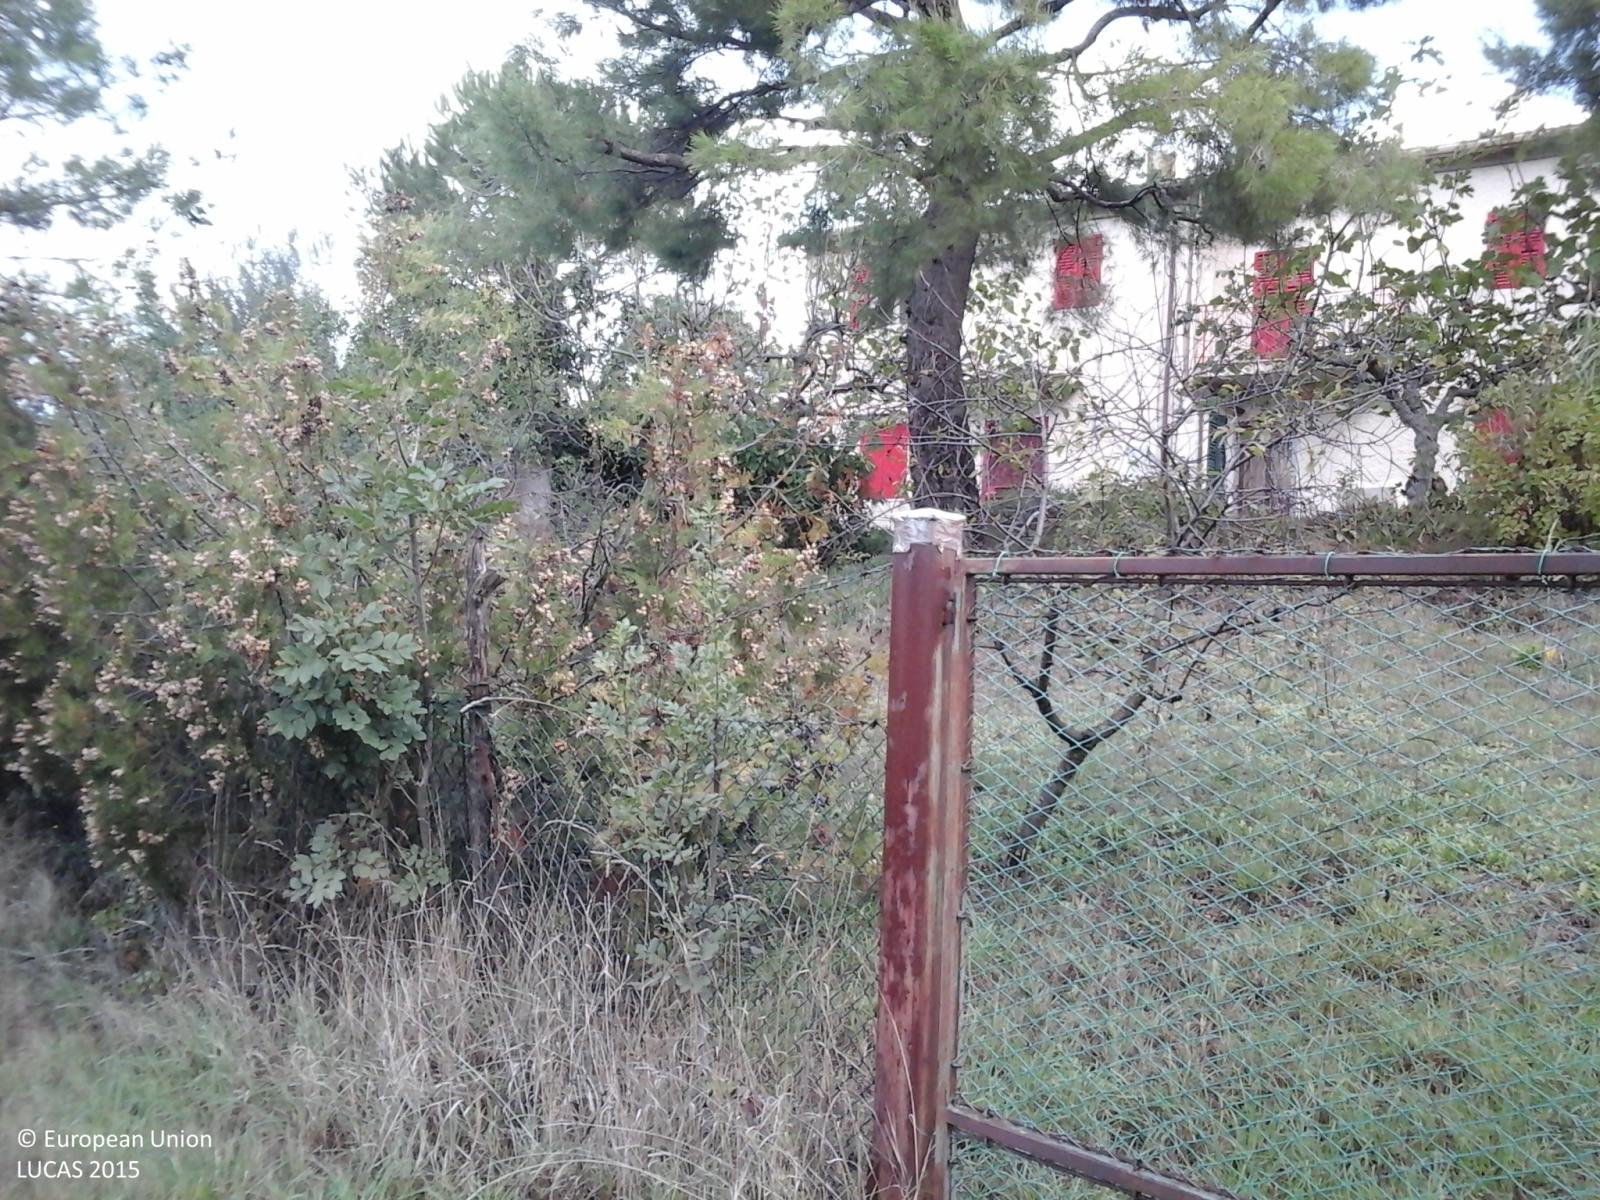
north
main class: Woodland
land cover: Pine dominated mixed woodland
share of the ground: > 75 %
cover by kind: coniferous forest trees 40 %, herbaceous plants 40 %, broadleaved forest trees 20 %
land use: Residential
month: October
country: IT
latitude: 43.5744
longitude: 13.3476
